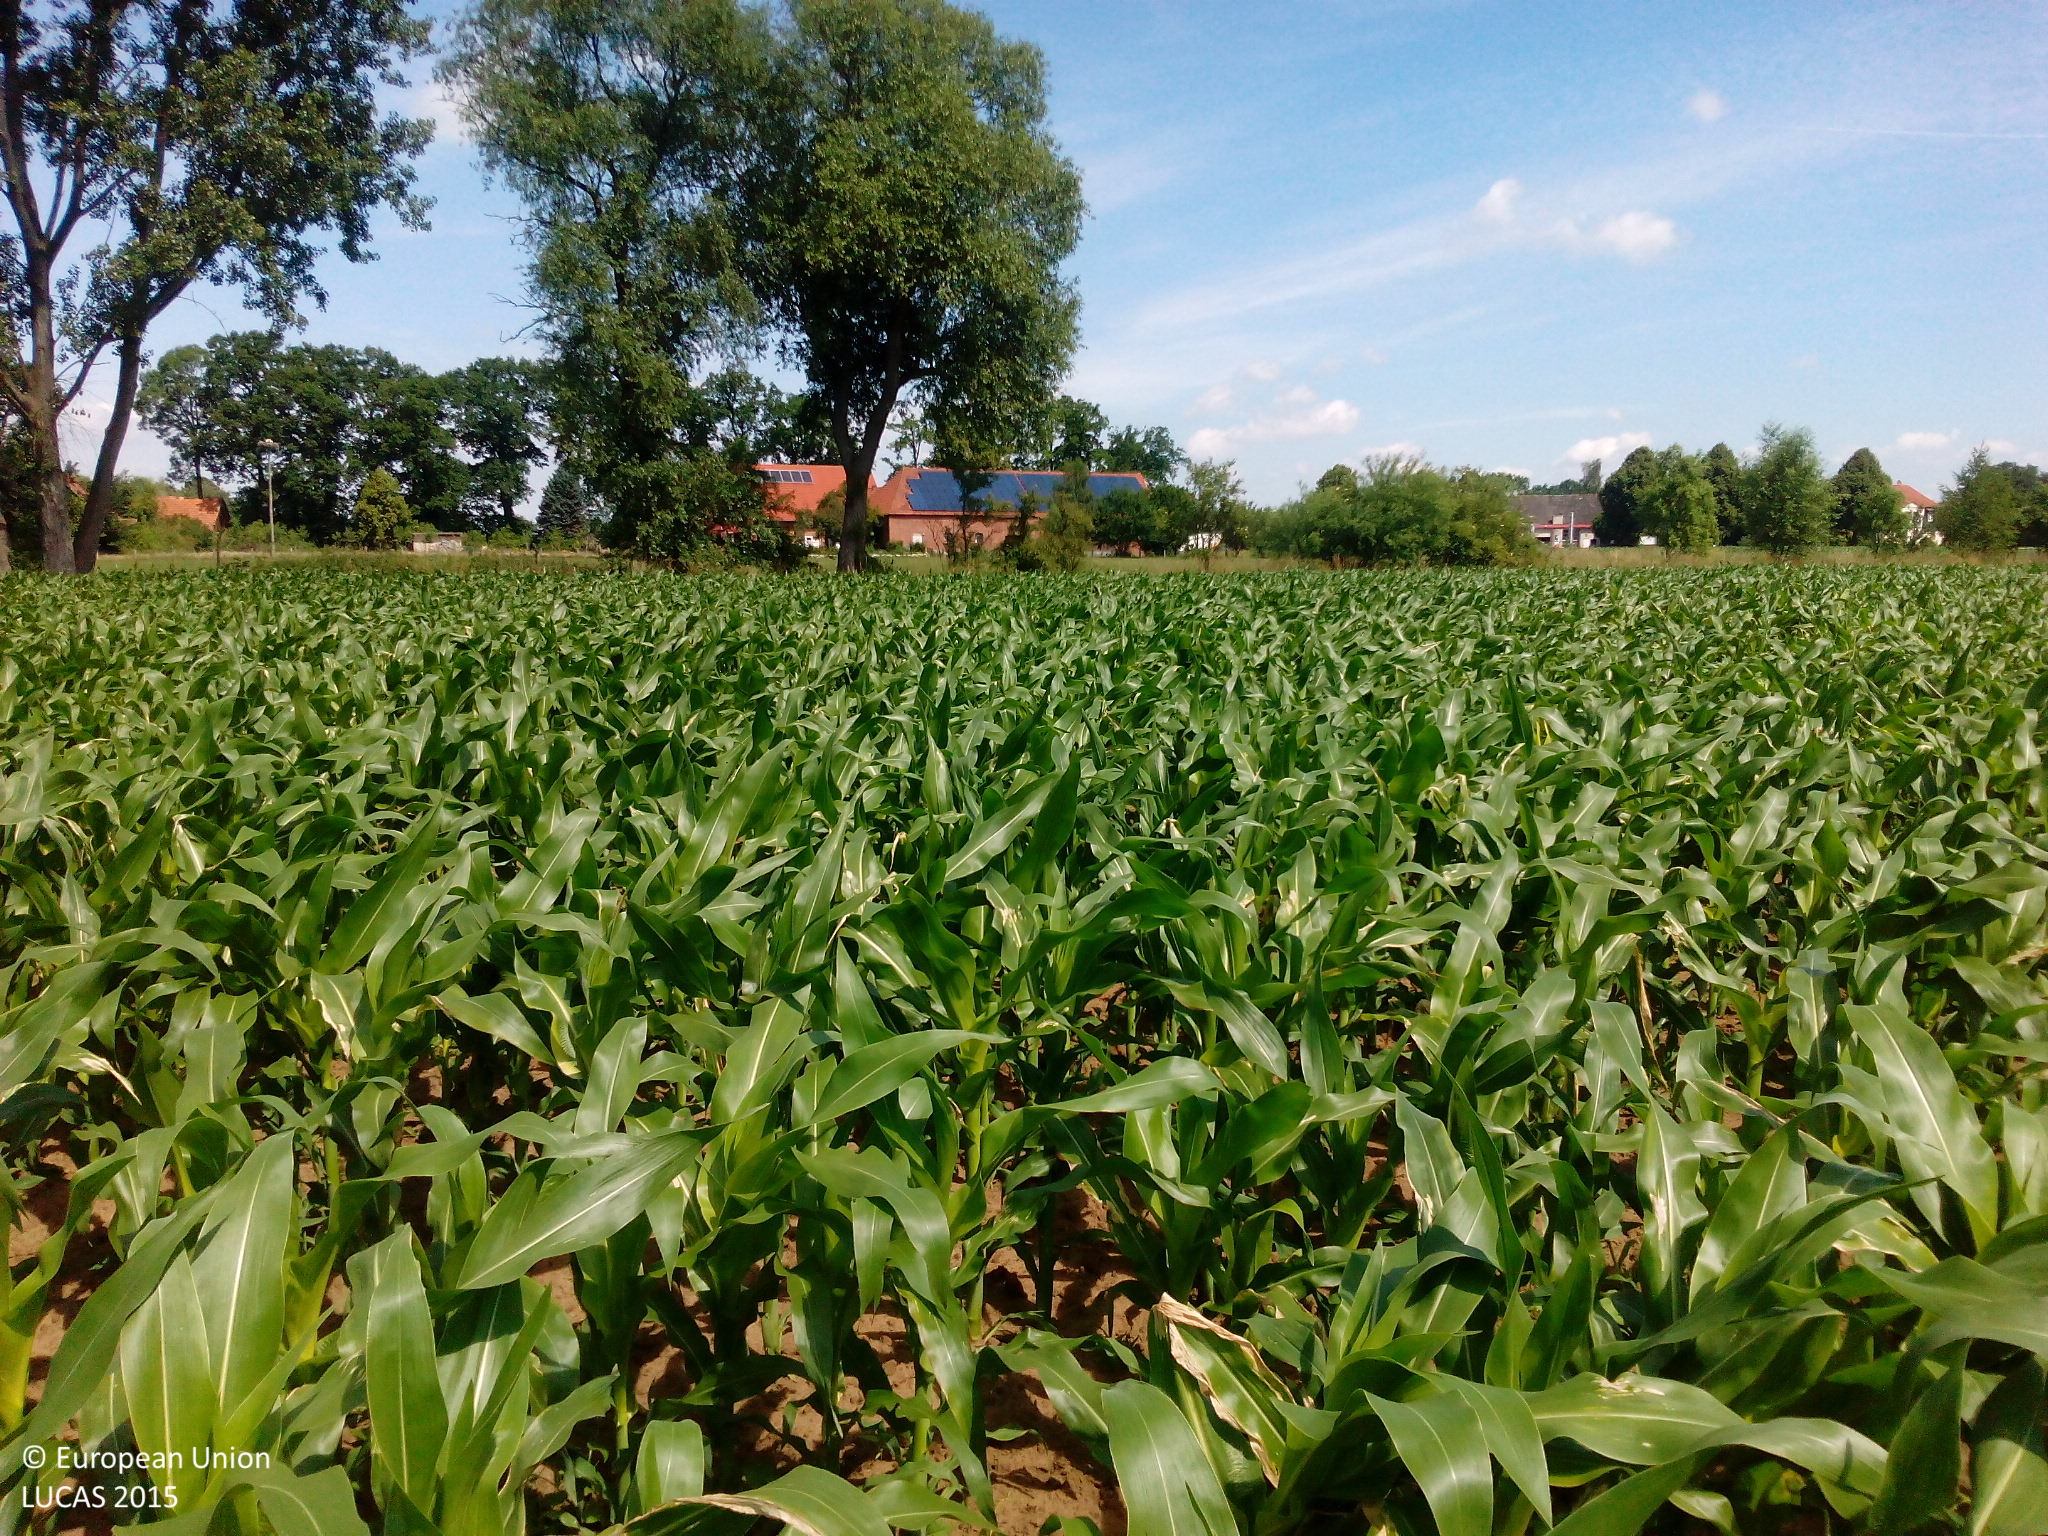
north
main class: Cropland
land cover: Maize
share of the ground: > 75 %
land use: Agriculture (excluding fallow land and kitchen gardens)
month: June
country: DE
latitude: 51.7026
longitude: 8.4810
